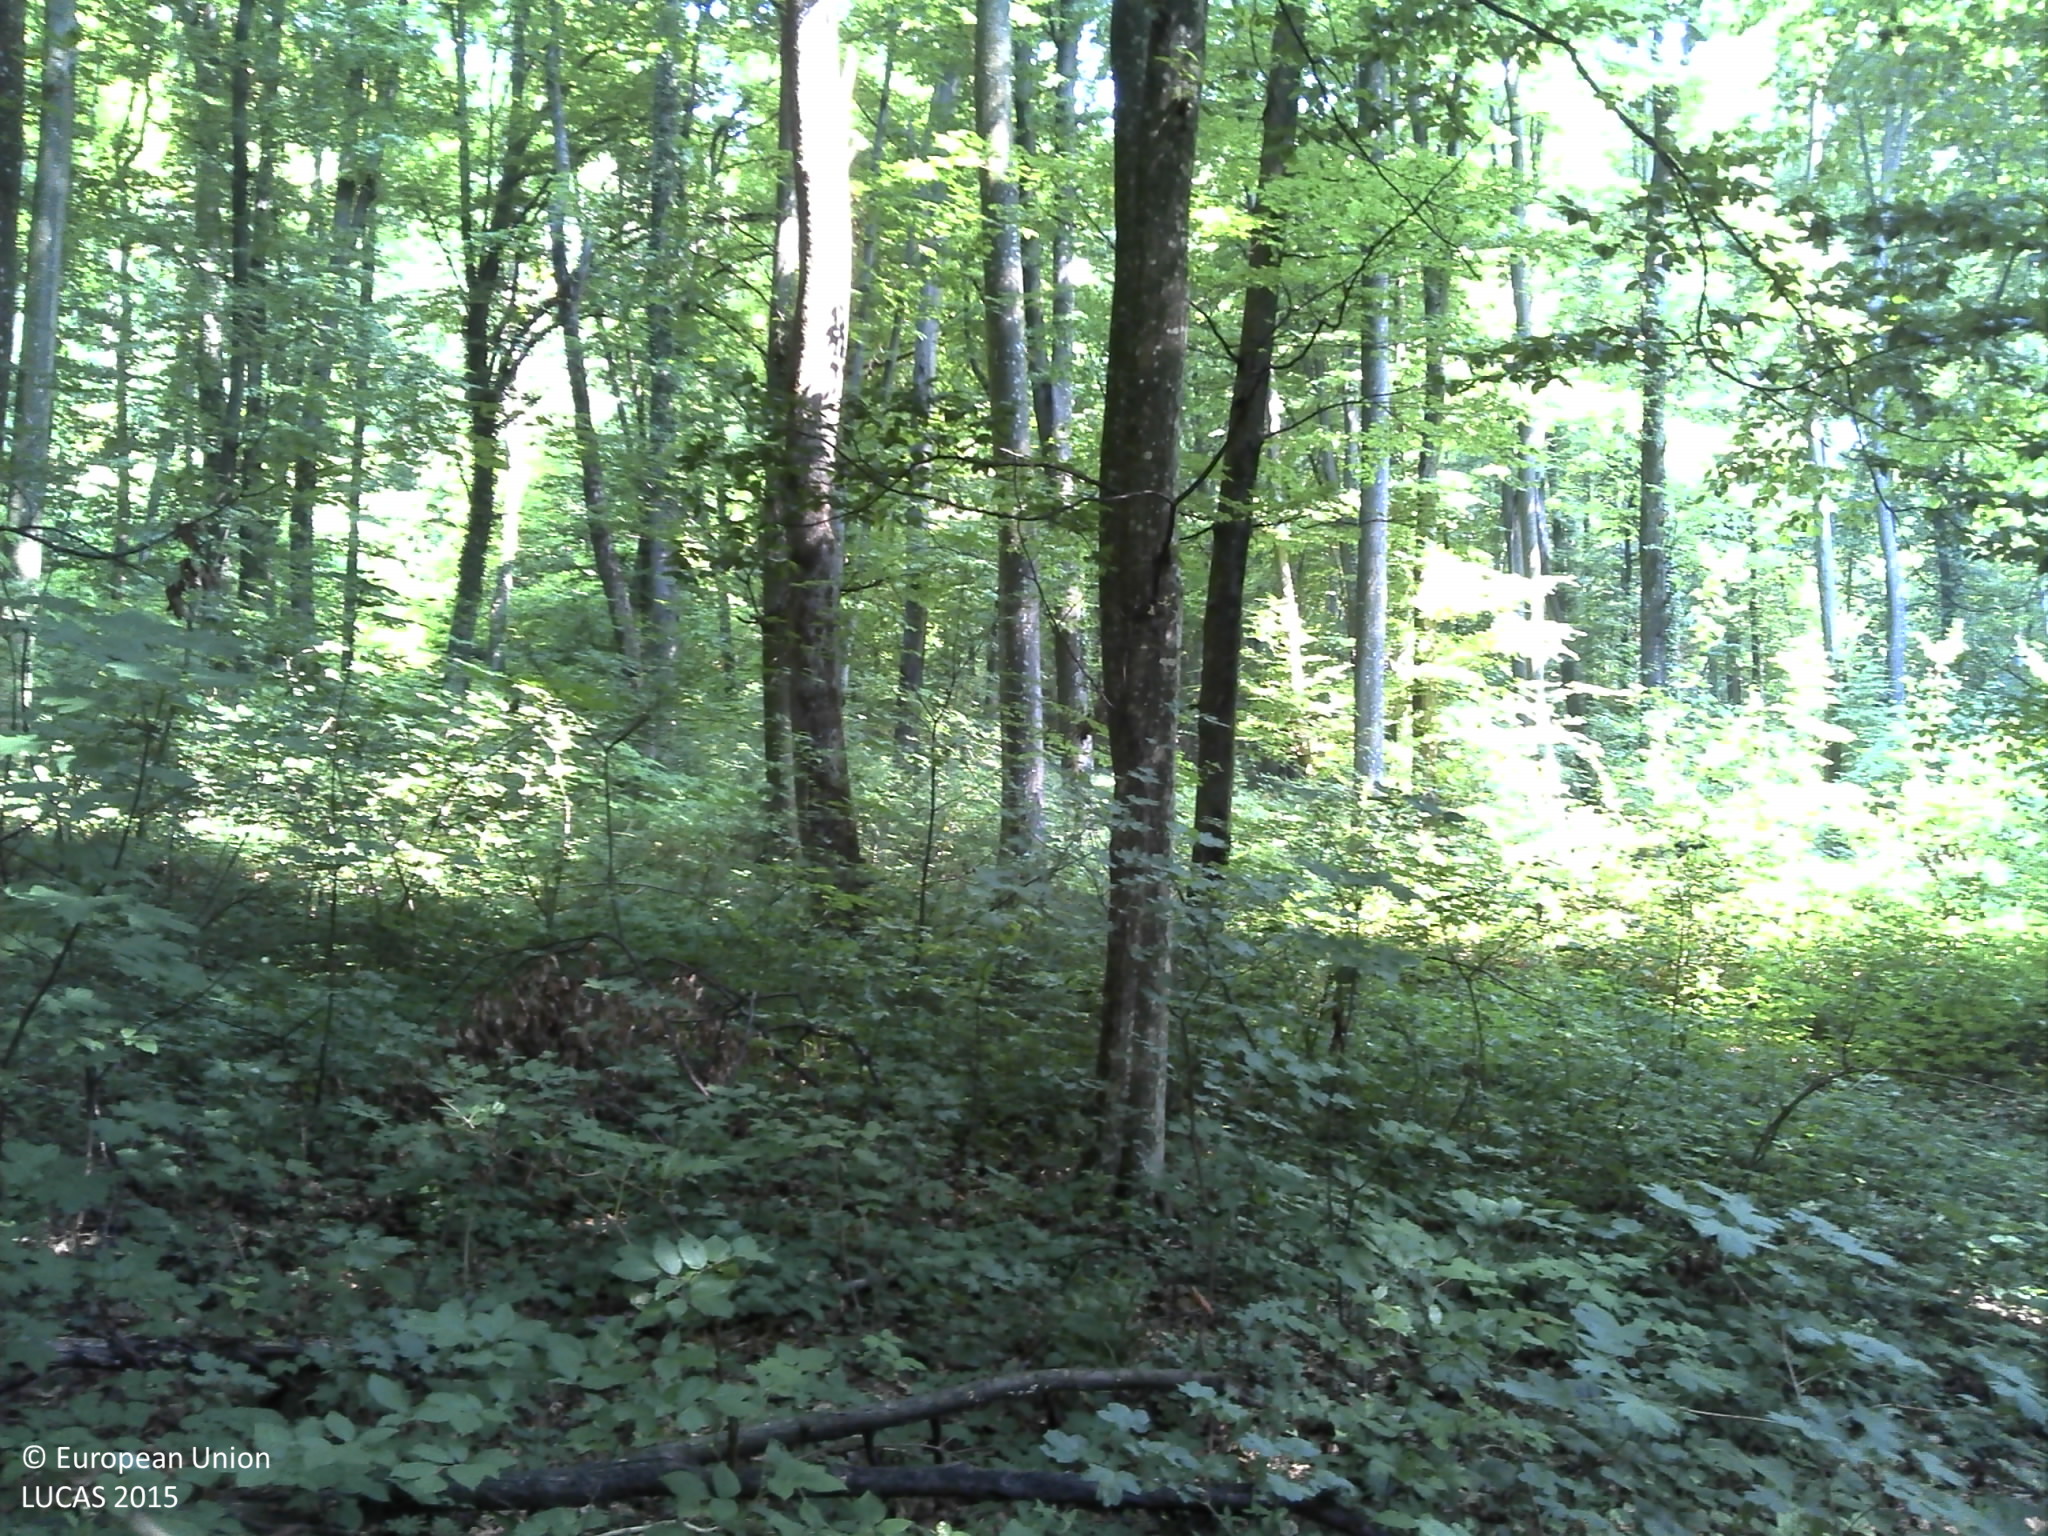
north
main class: Woodland
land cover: Broadleaved woodland
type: beech forest
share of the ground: > 75 %
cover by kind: broadleaved forest trees 90 %, shrubs 5 %, lichens and mosses 5 %
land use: Forestry
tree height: > 5 m
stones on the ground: < 10 %
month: June
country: HR
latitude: 45.2418
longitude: 18.1696
